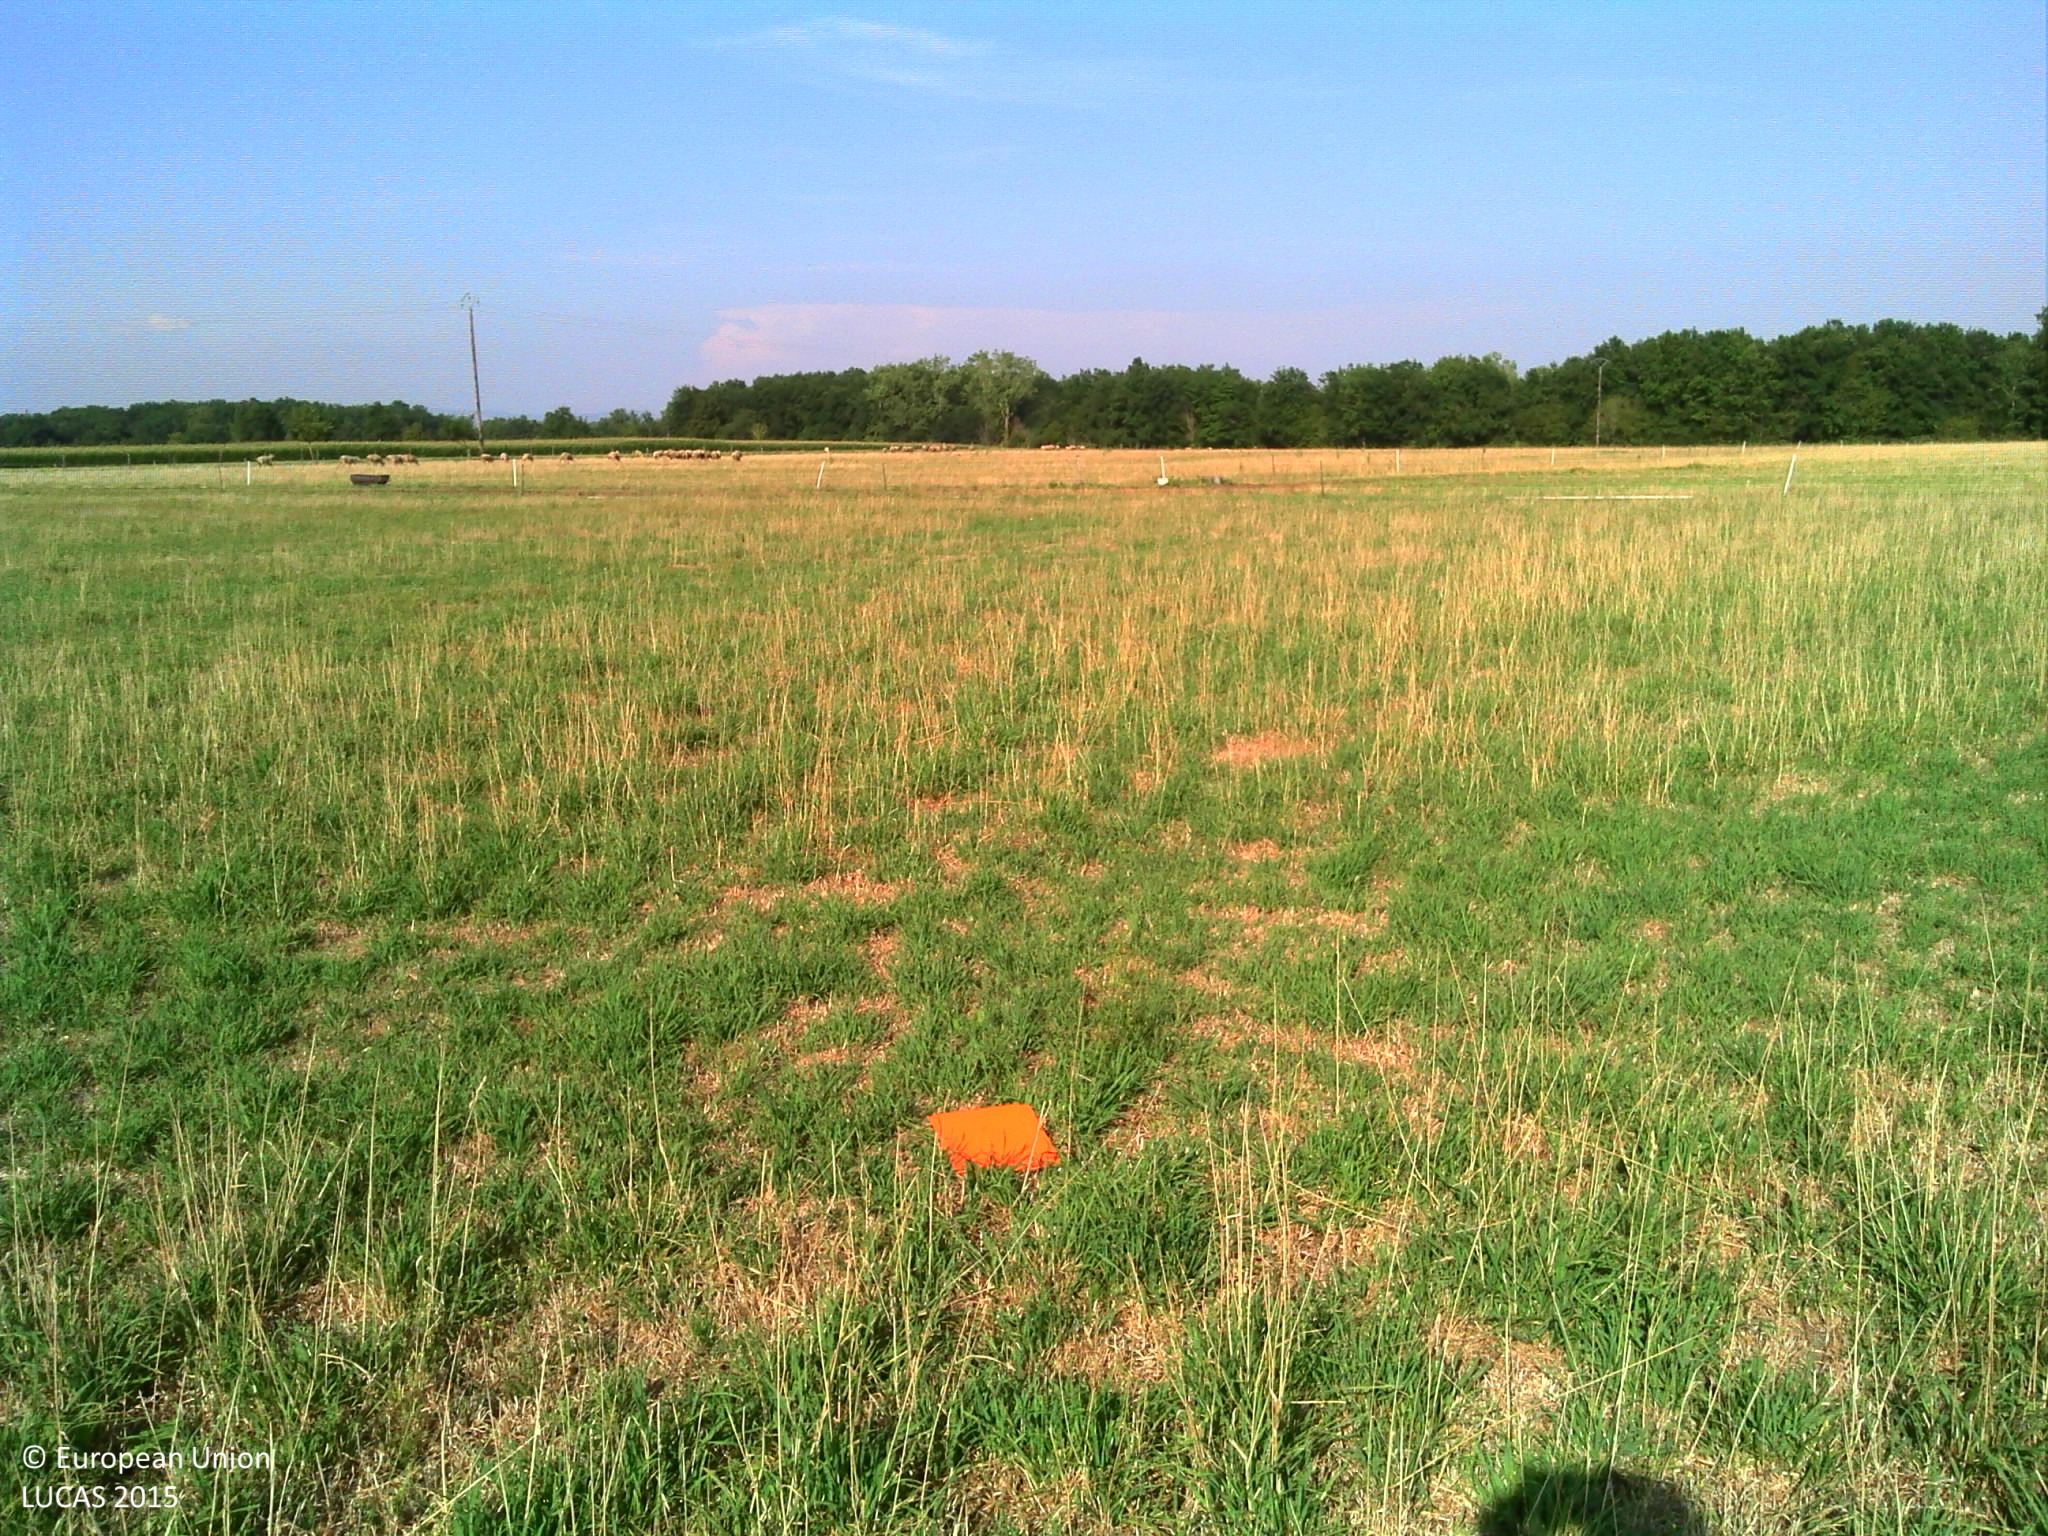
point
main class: Grassland
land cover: Grassland without tree/shrub cover
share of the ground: > 75 %
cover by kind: herbaceous plants 100 %
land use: Agriculture (excluding fallow land and kitchen gardens)
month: August
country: FR
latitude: 45.6832
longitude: 4.1094
